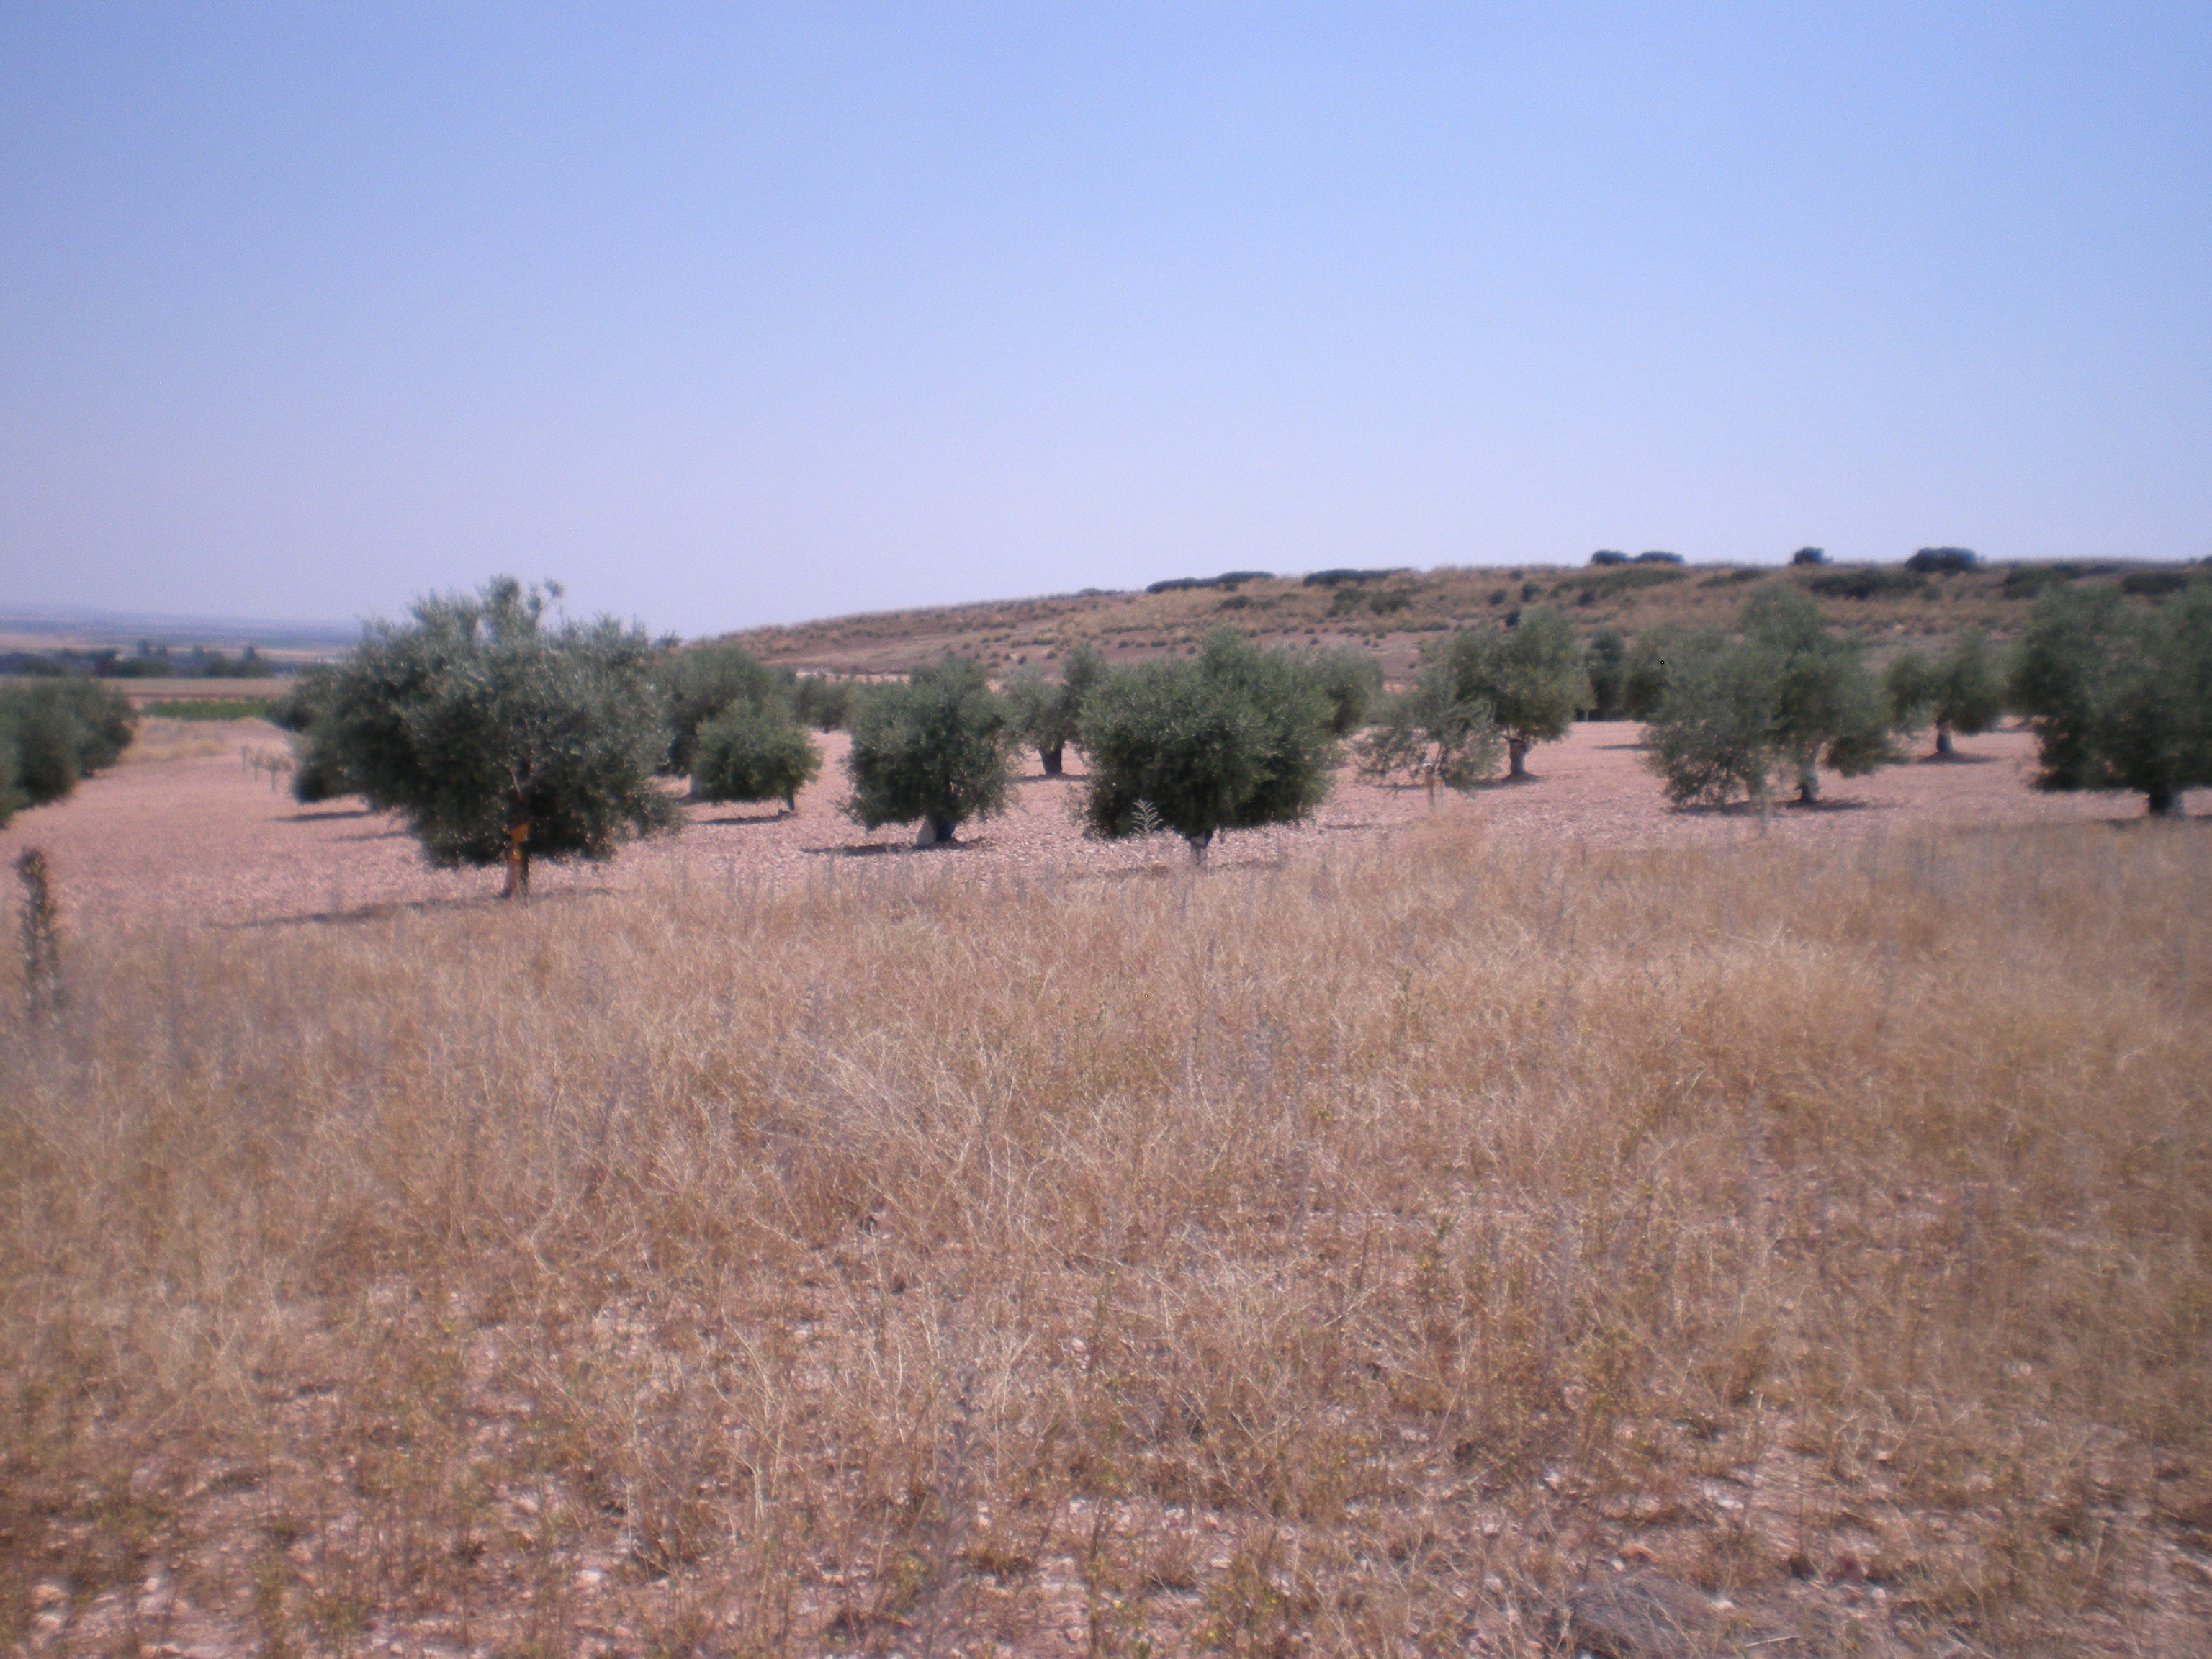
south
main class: Grassland
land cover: Spontaneously vegetated surfaces
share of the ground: 25 - 50 %
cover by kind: unconsolidated bare surface 70 %, herbaceous plants 30 %
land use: Abandoned areas
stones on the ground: < 10 %
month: June
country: ES
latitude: 39.6236
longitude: -3.3615
